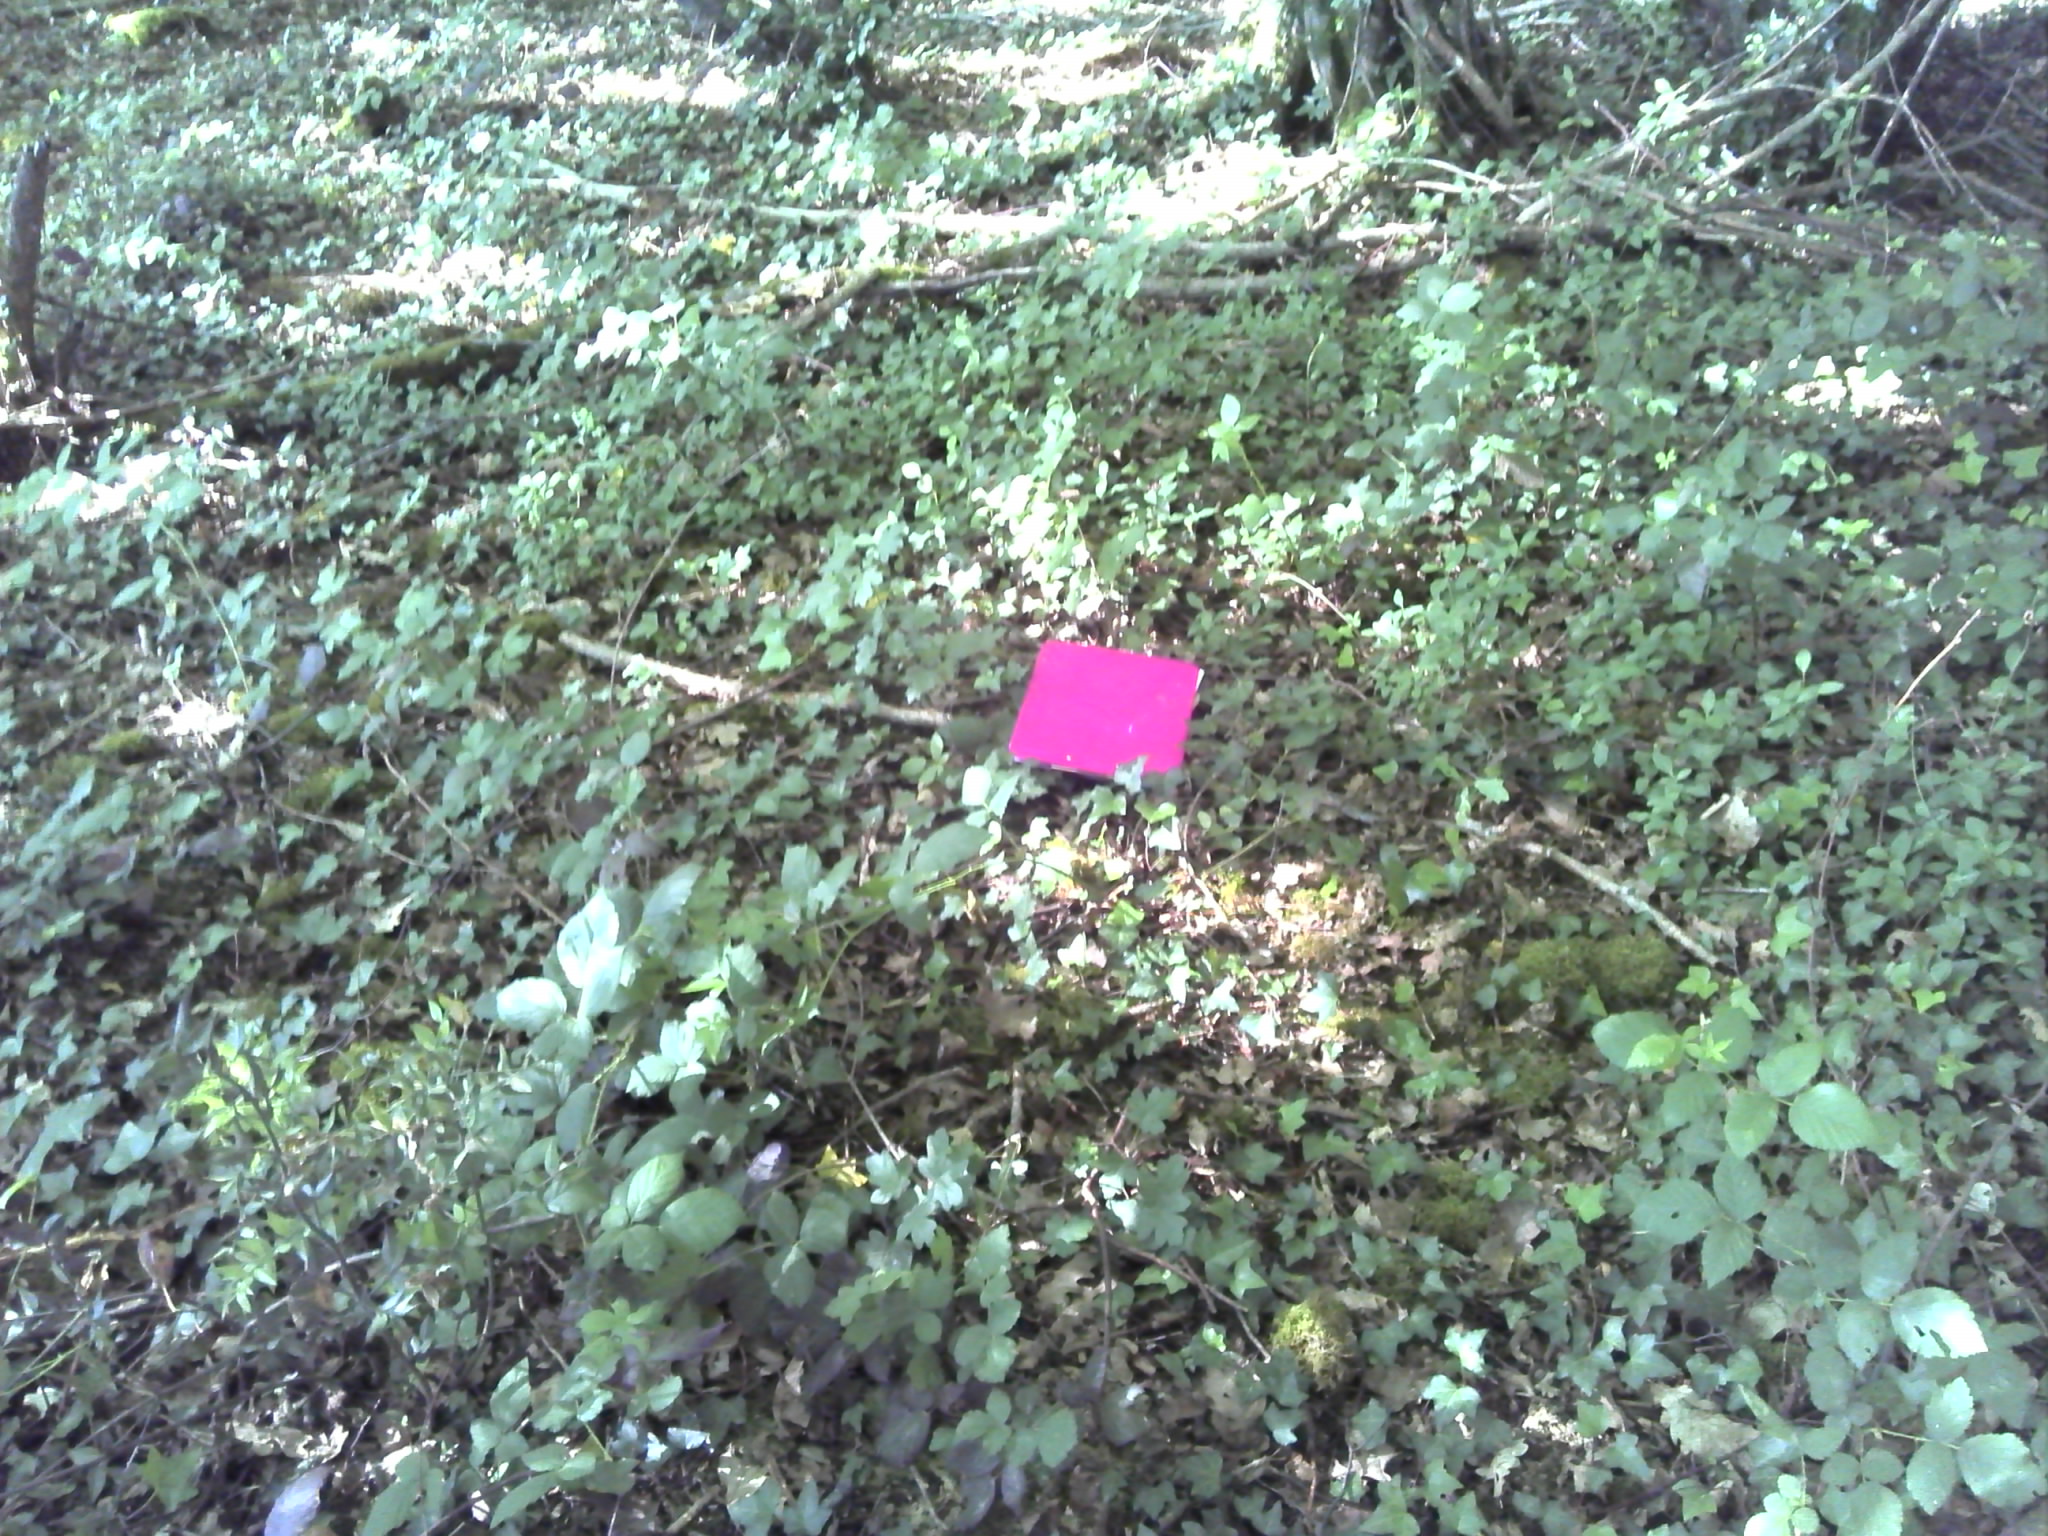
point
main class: Woodland
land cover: Broadleaved woodland
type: mesophytic deciduous forest
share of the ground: > 75 %
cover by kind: broadleaved forest trees 90 %, herbaceous plants 10 %
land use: Forestry
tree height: > 5 m
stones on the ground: < 10 %
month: June
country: FR
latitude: 46.6054
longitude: 1.6740
